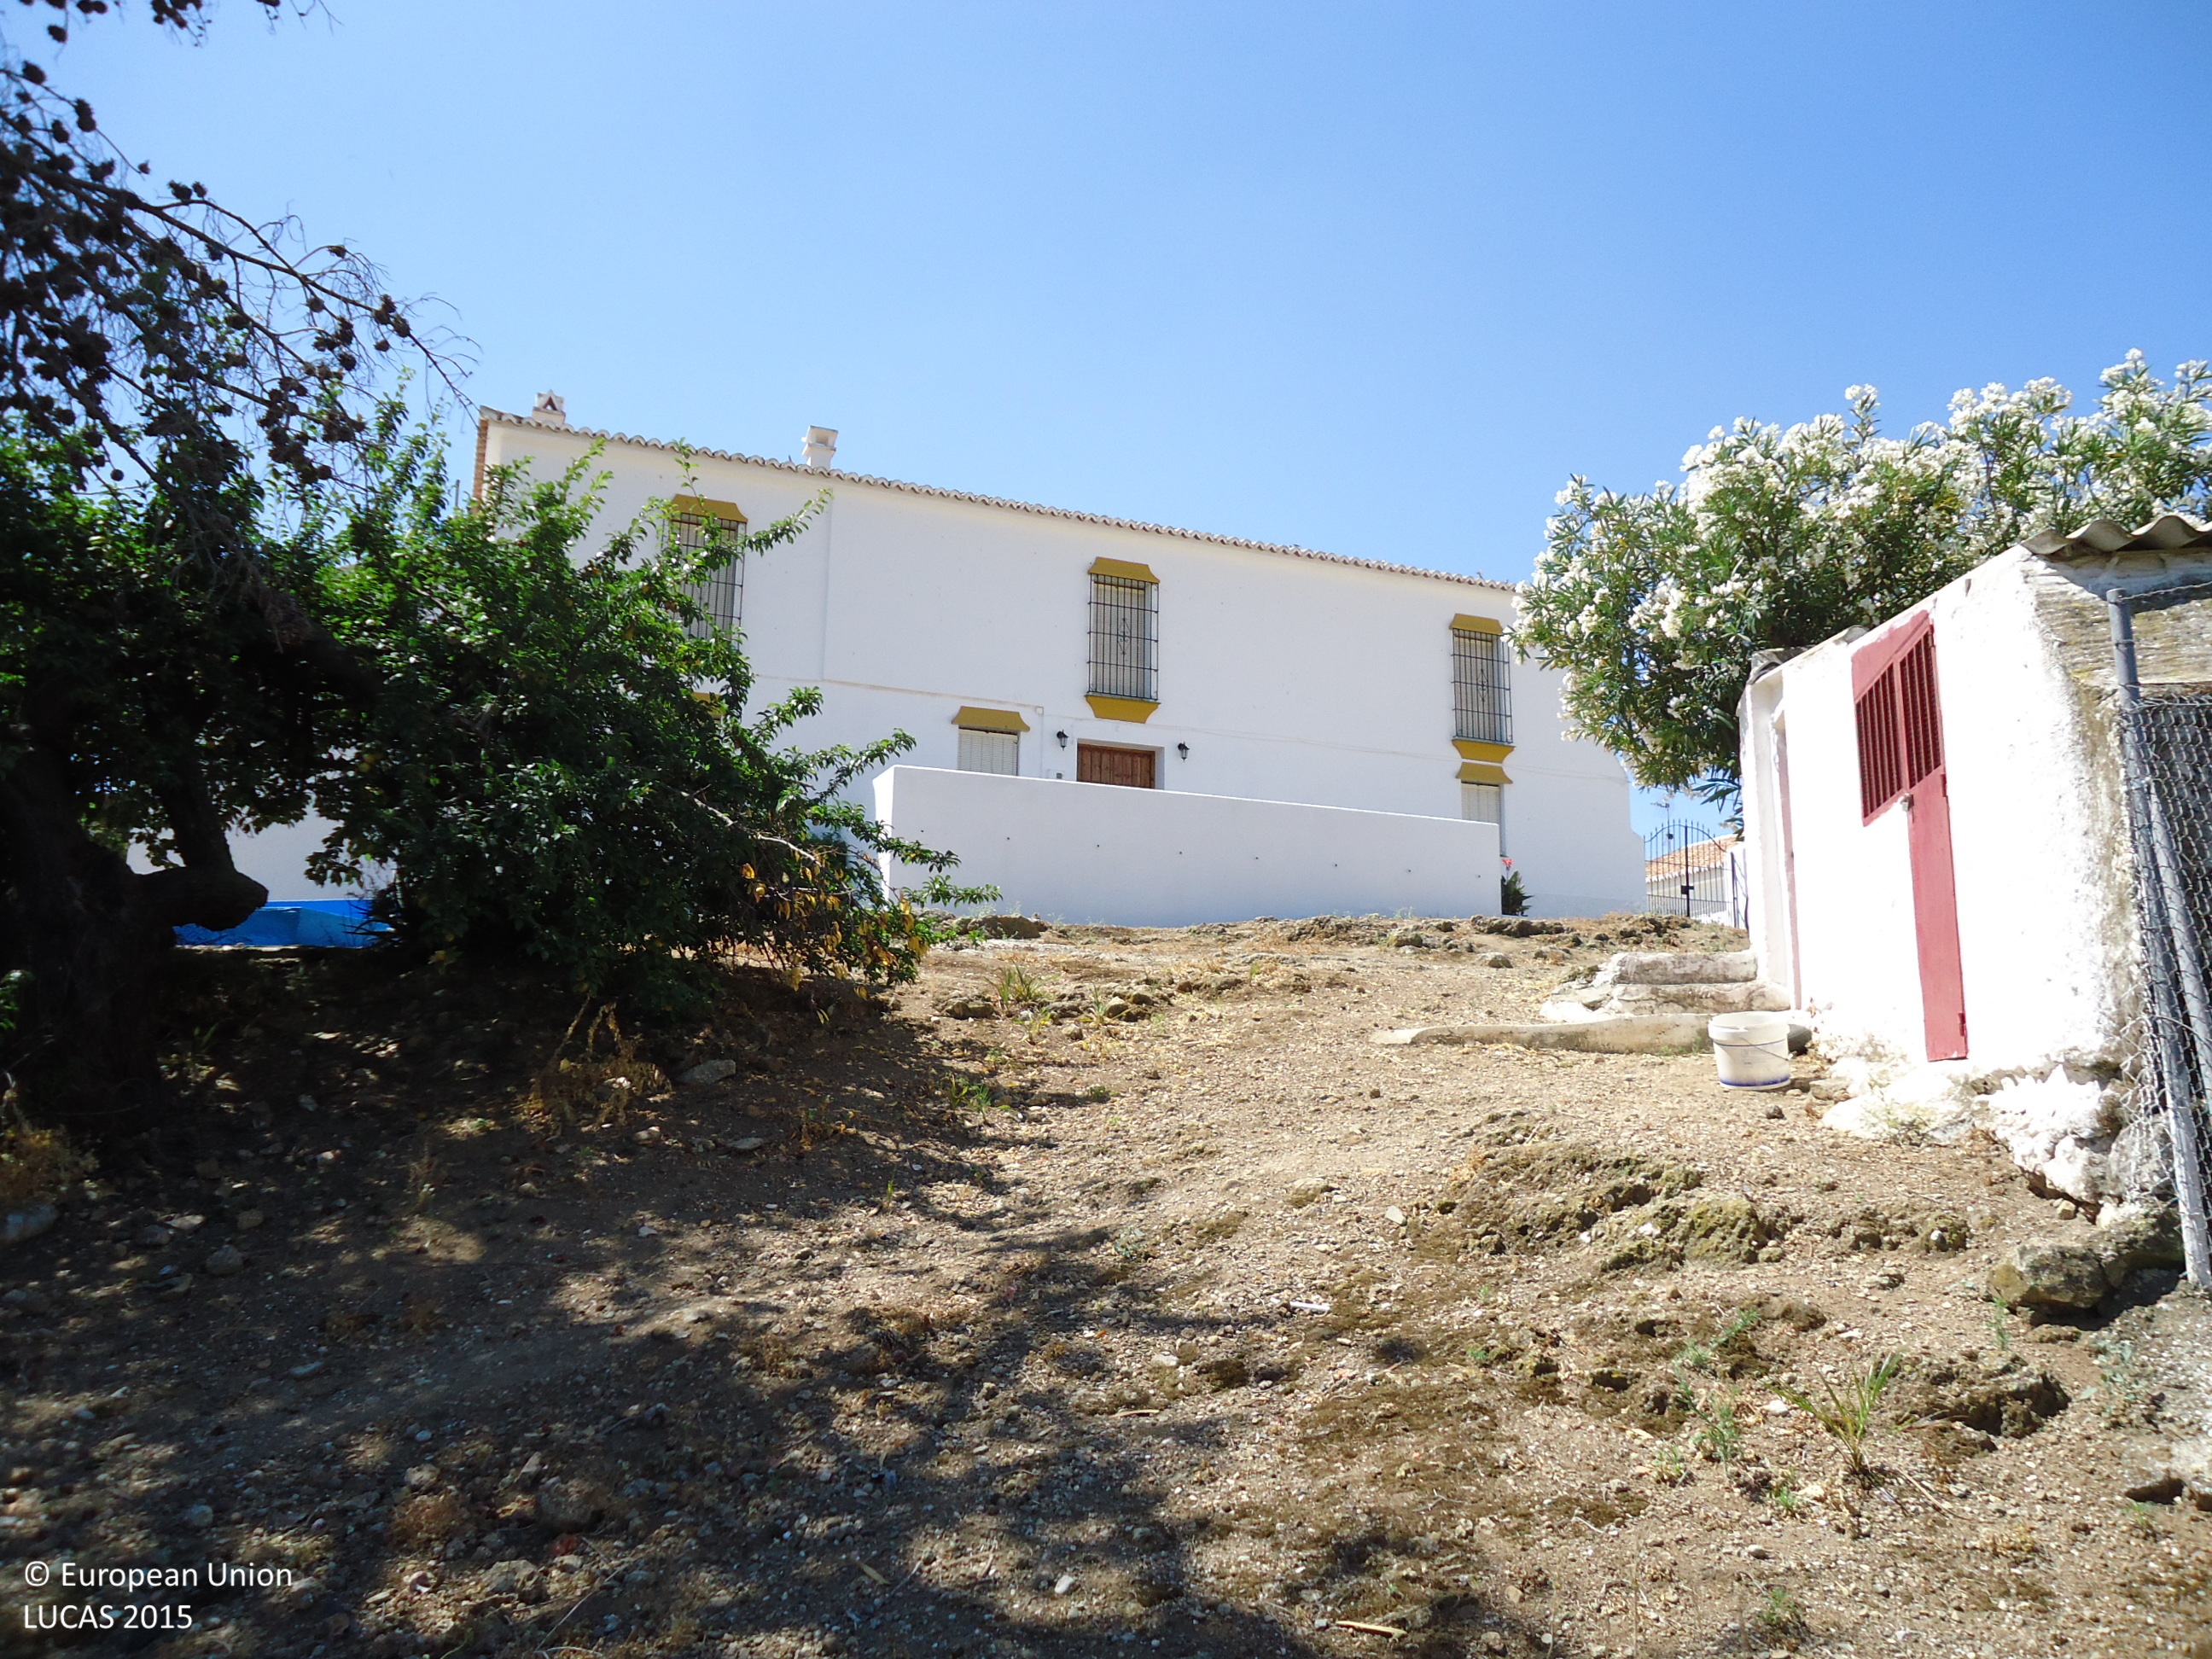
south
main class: Cropland
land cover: Other citrus fruit
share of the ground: > 75 %
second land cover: Other bare soil
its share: > 75 %
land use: Agriculture (excluding fallow land and kitchen gardens)
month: June
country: ES
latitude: 36.8313
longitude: -4.7397
